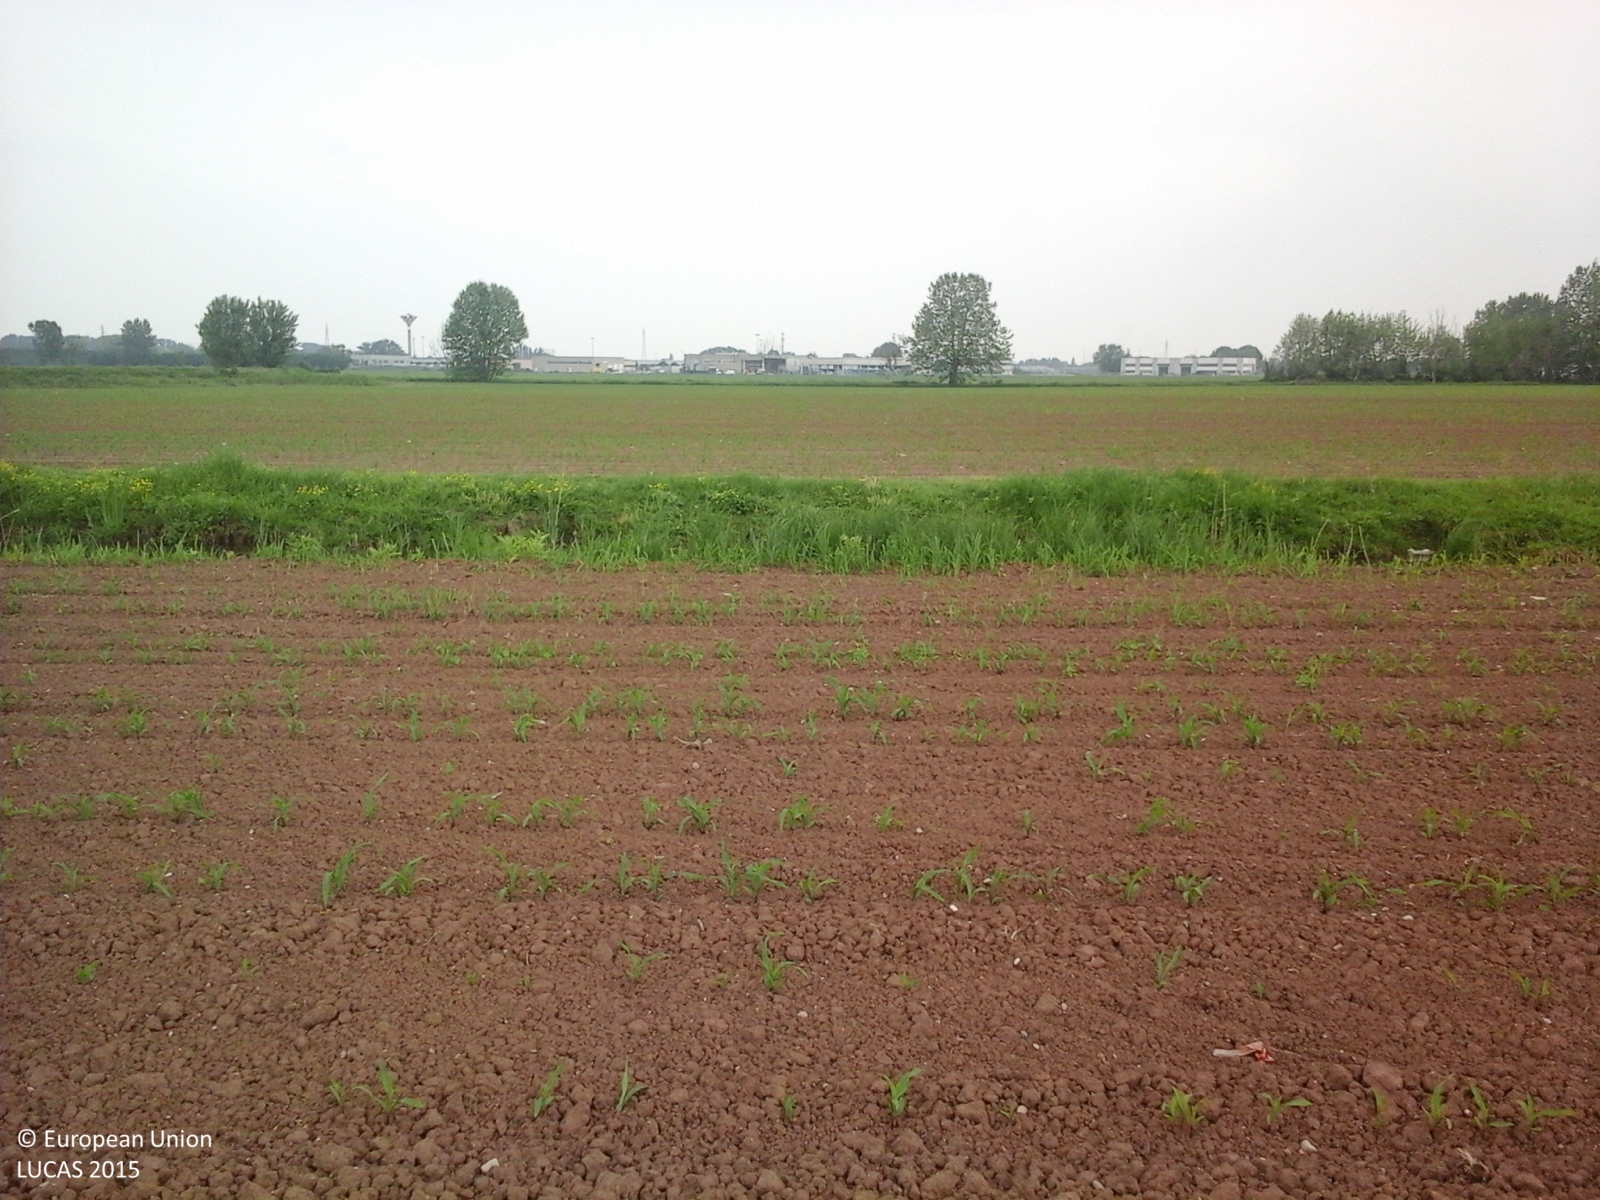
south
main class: Cropland
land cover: Maize
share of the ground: < 10 %
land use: Agriculture (excluding fallow land and kitchen gardens)
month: May
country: IT
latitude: 45.2333
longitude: 10.3941
